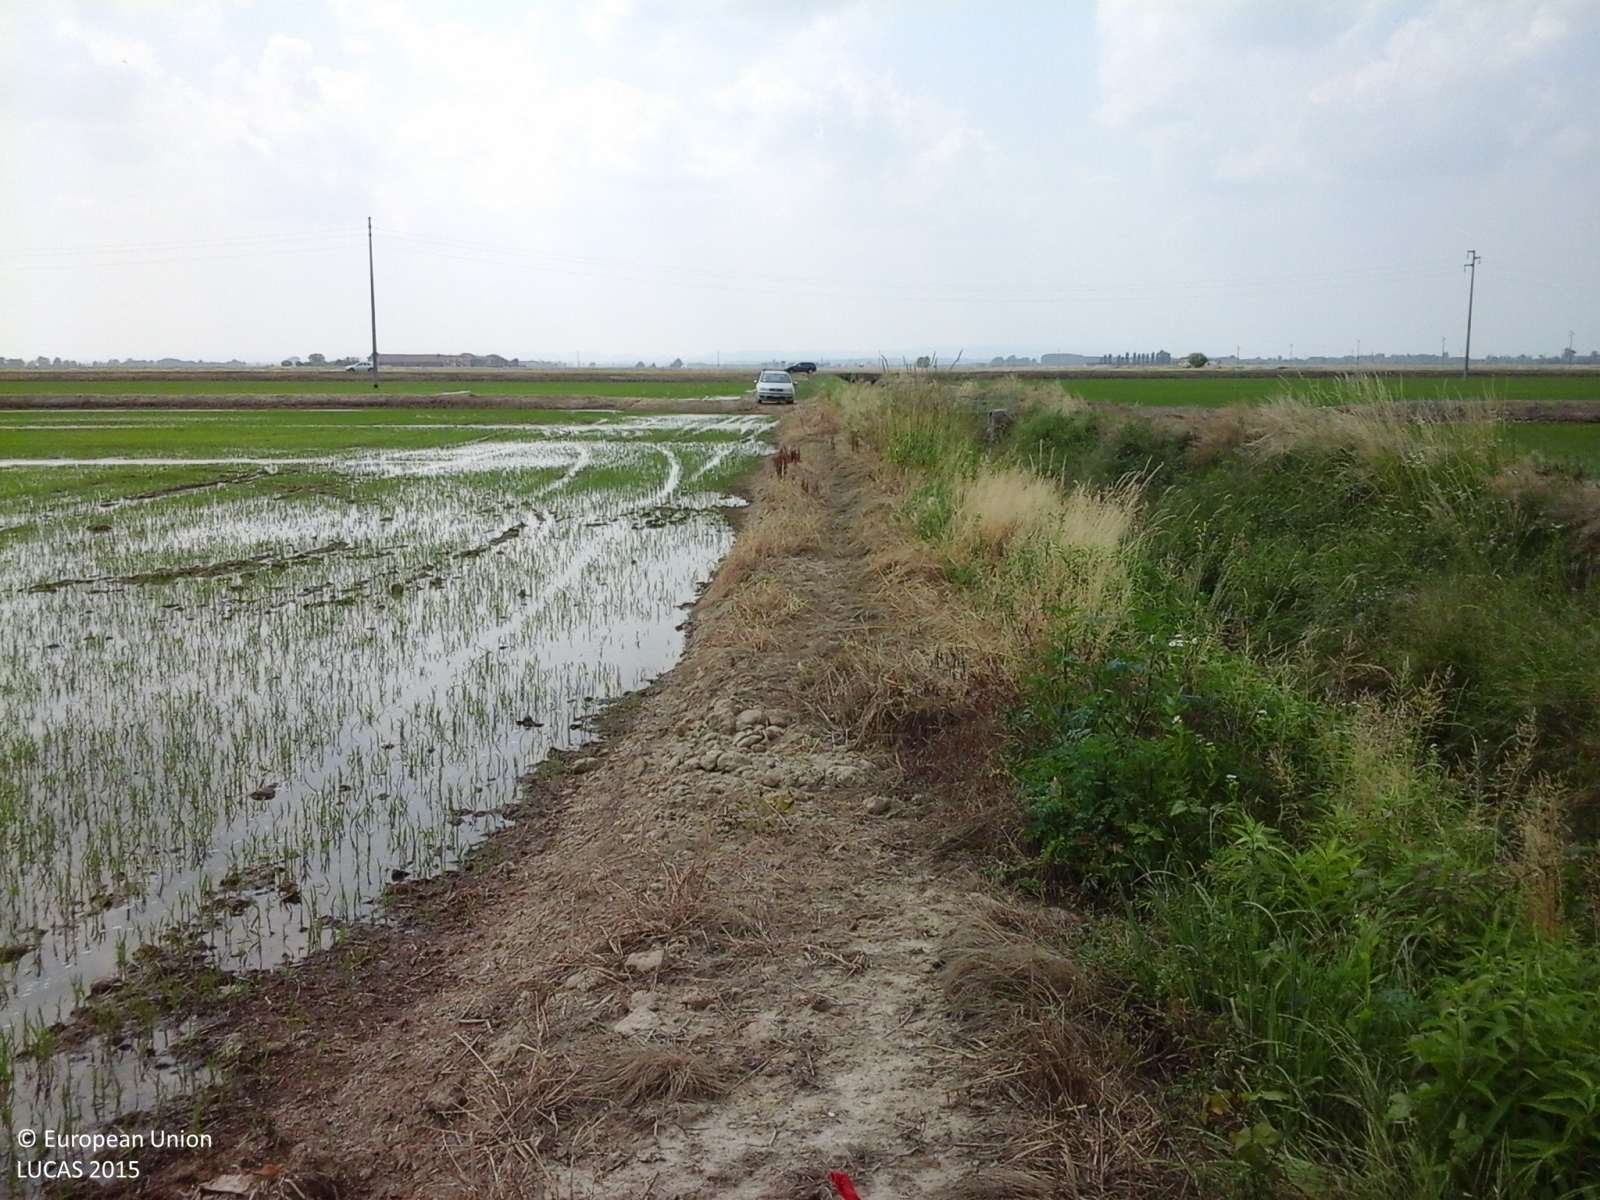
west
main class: Cropland
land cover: Rice
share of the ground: 25 - 50 %
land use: Agriculture (excluding fallow land and kitchen gardens)
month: May
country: IT
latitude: 45.3826
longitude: 8.3043
